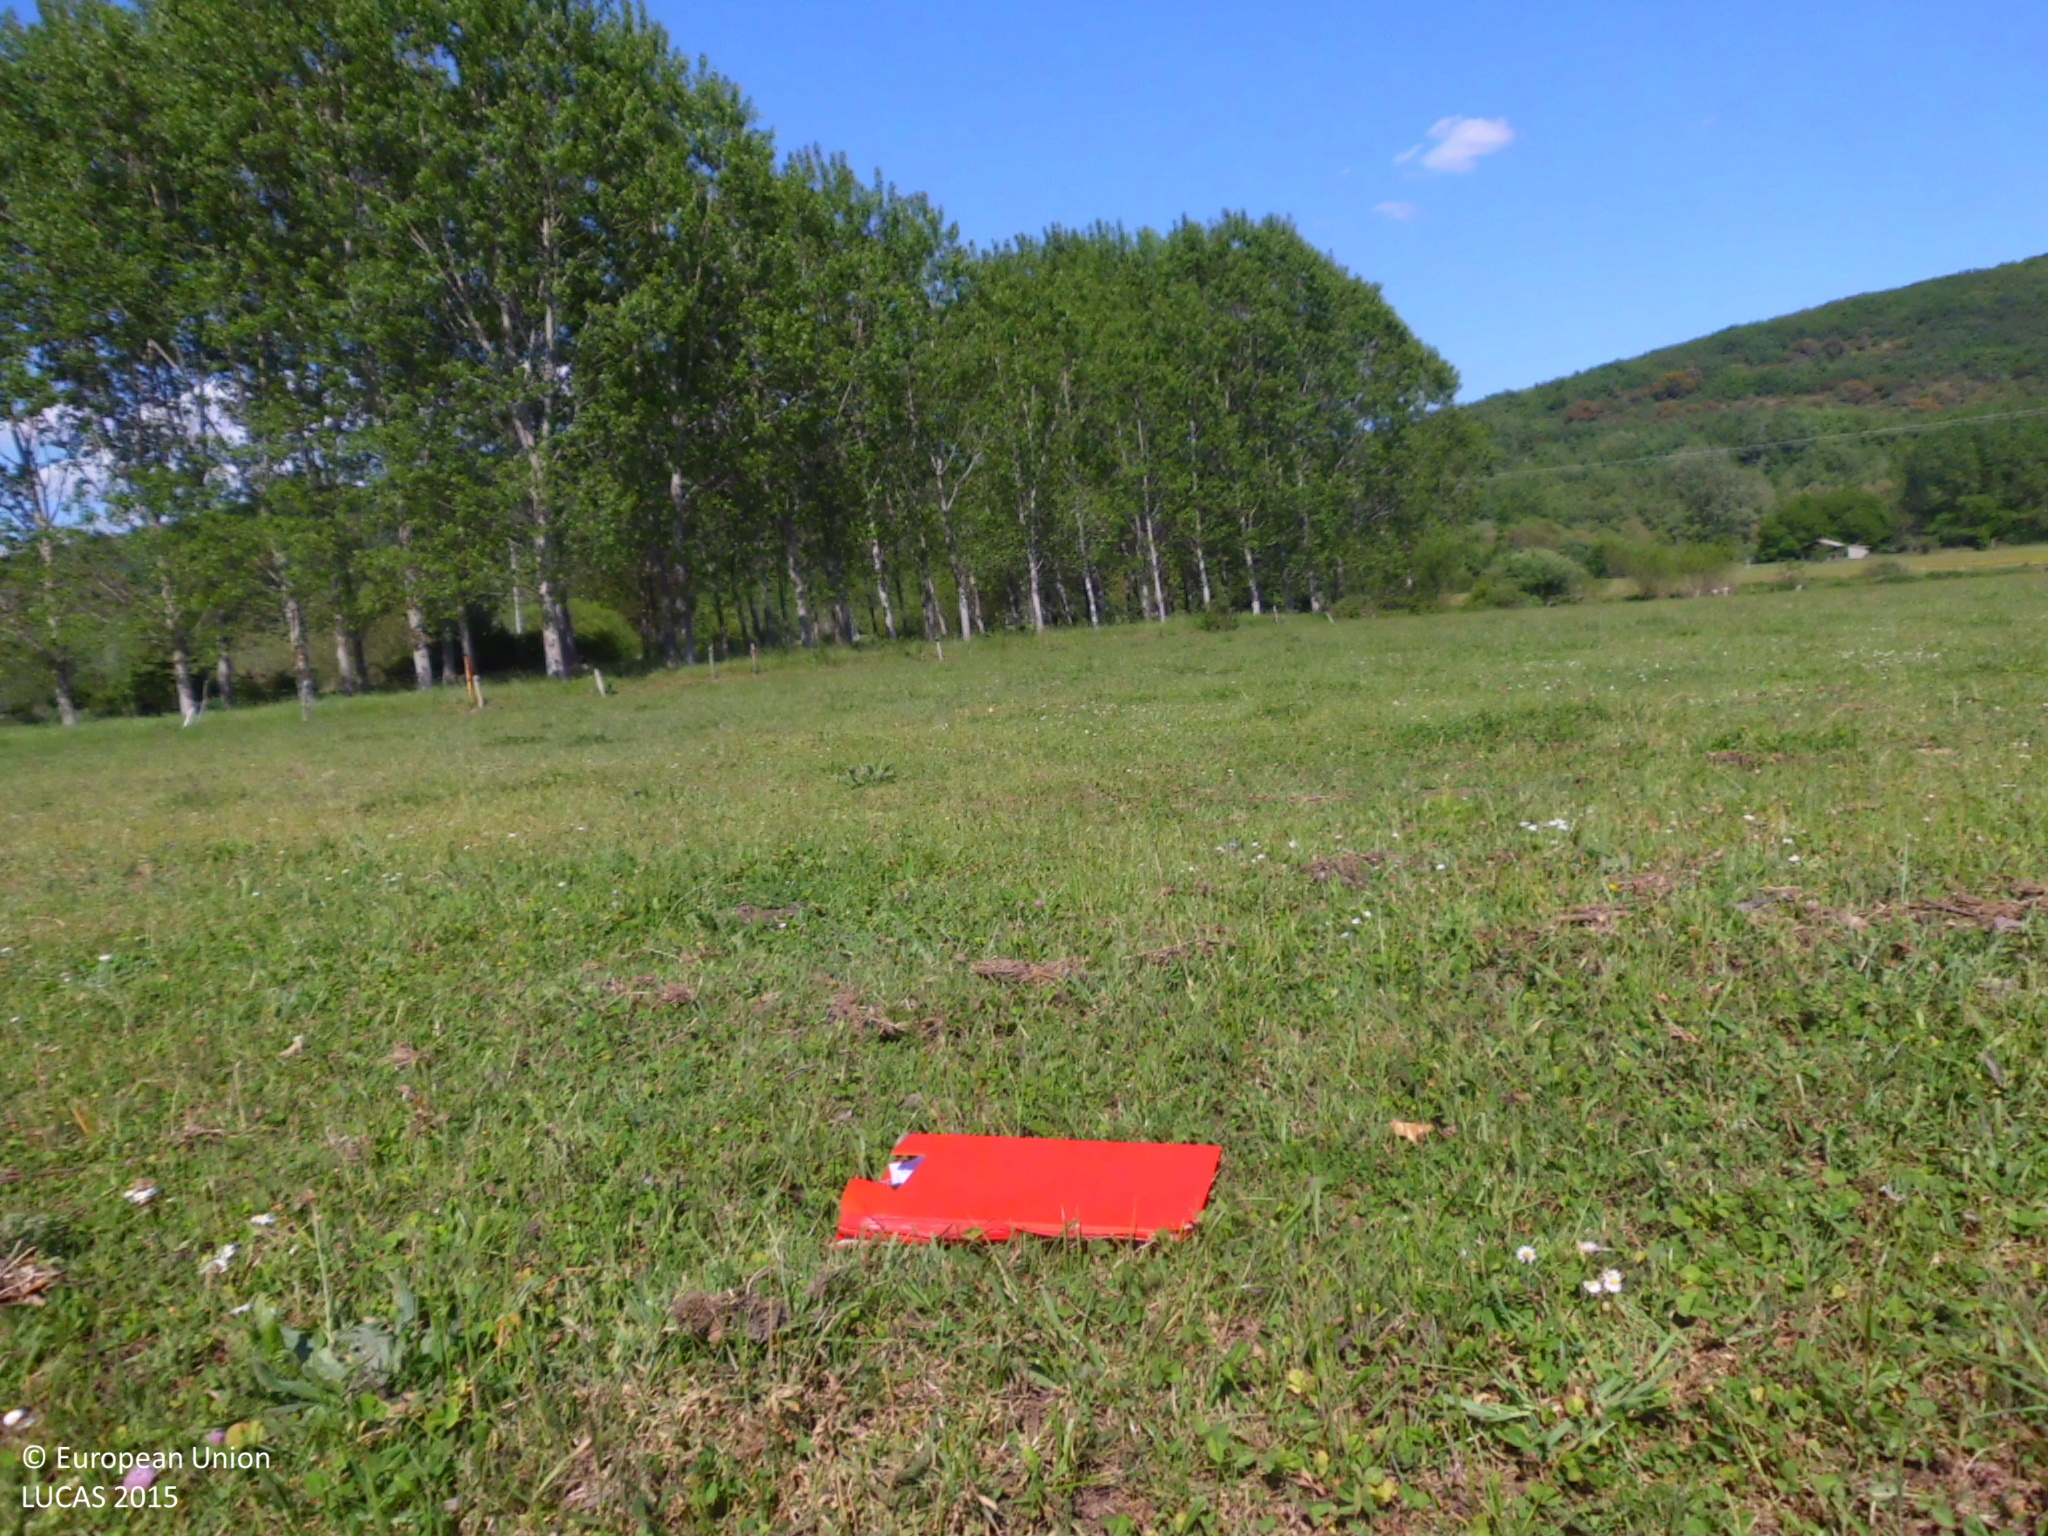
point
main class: Grassland
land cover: Grassland without tree/shrub cover
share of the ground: > 75 %
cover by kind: herbaceous plants 85 %, consolidated bare surface 10 %, shrubs 5 %
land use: Agriculture (excluding fallow land and kitchen gardens)
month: May
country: ES
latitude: 42.7871
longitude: -5.4136
